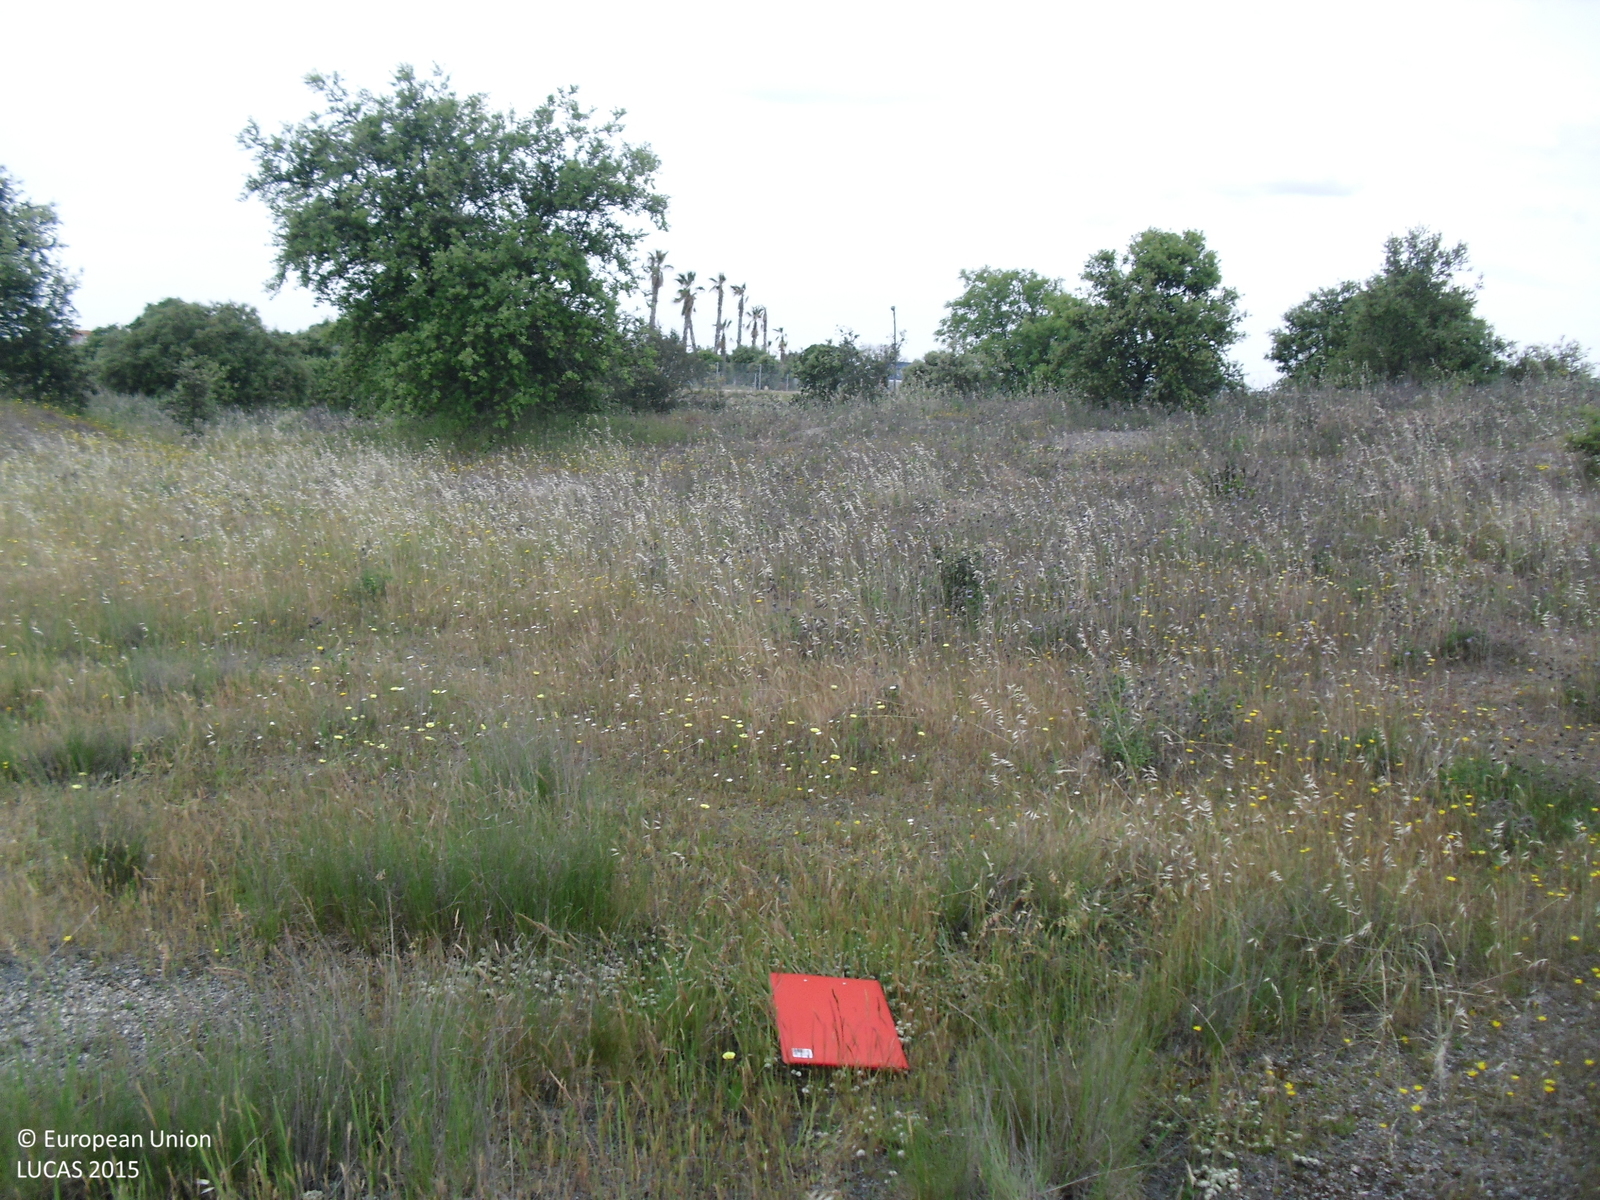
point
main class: Shrubland
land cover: Shrubland with sparse tree cover
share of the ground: > 75 %
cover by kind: herbaceous plants 75 %, shrubs 20 %, broadleaved forest trees 5 %
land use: Semi-natural and natural areas not in use
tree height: < 5 m
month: April
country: ES
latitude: 39.4584
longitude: -6.4446
